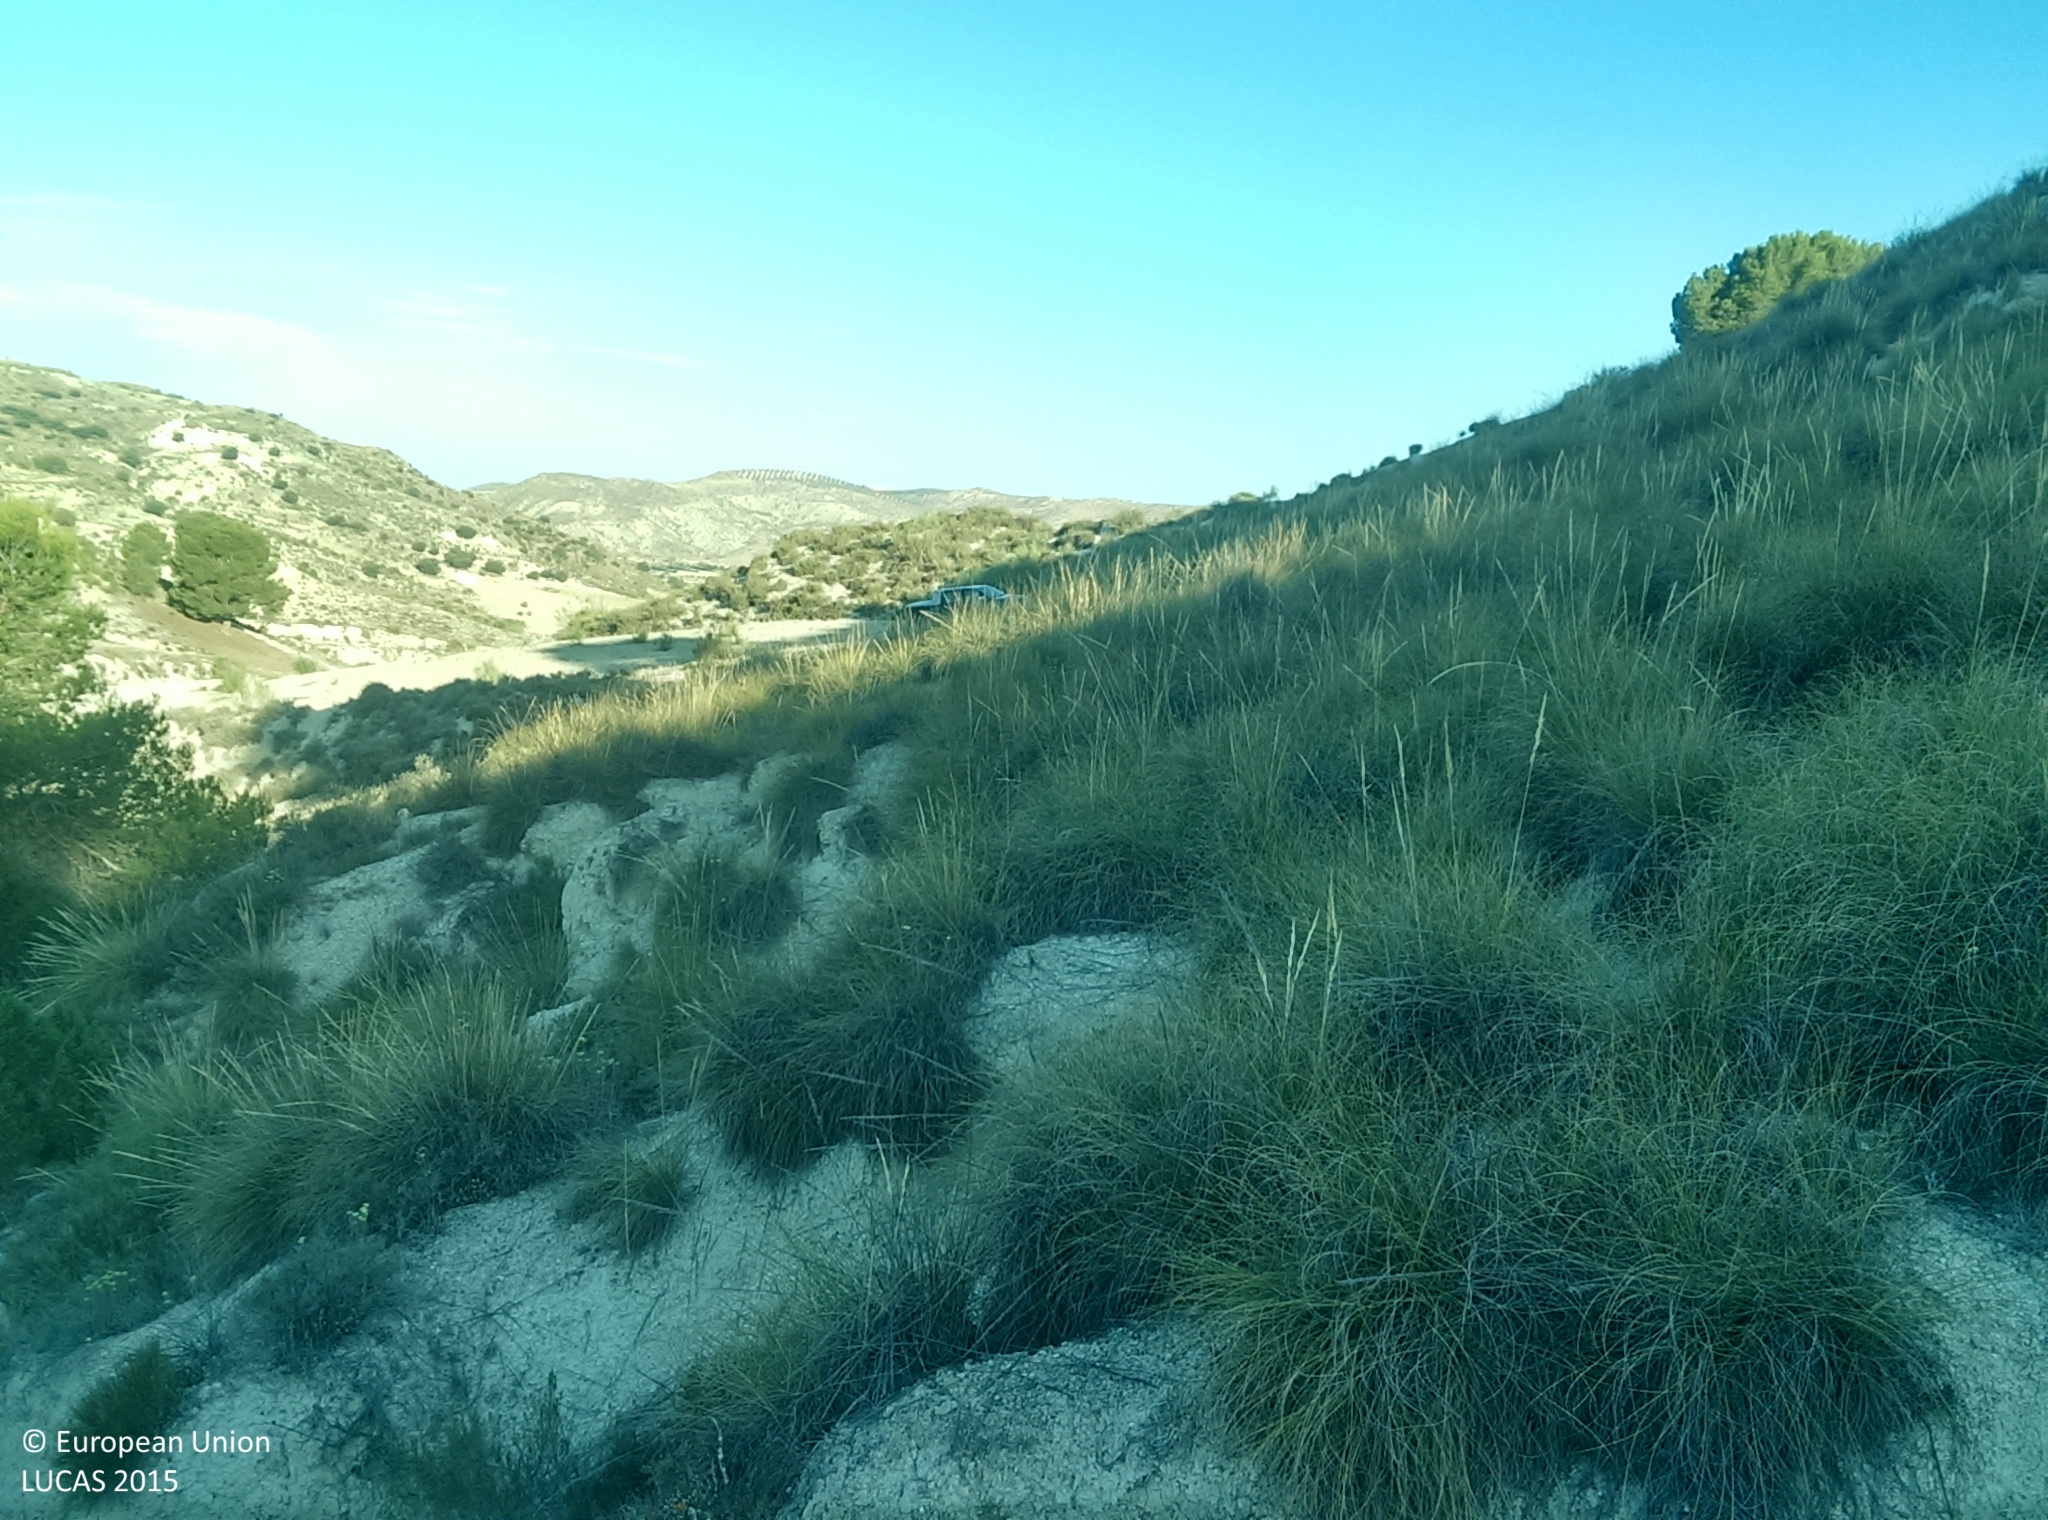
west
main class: Shrubland
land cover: Shrubland without tree cover
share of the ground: 25 - 50 %
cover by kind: herbaceous plants 60 %, shrubs 30 %, unconsolidated bare surface 10 %
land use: Forestry
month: June
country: ES
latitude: 37.5954
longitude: -3.1868
